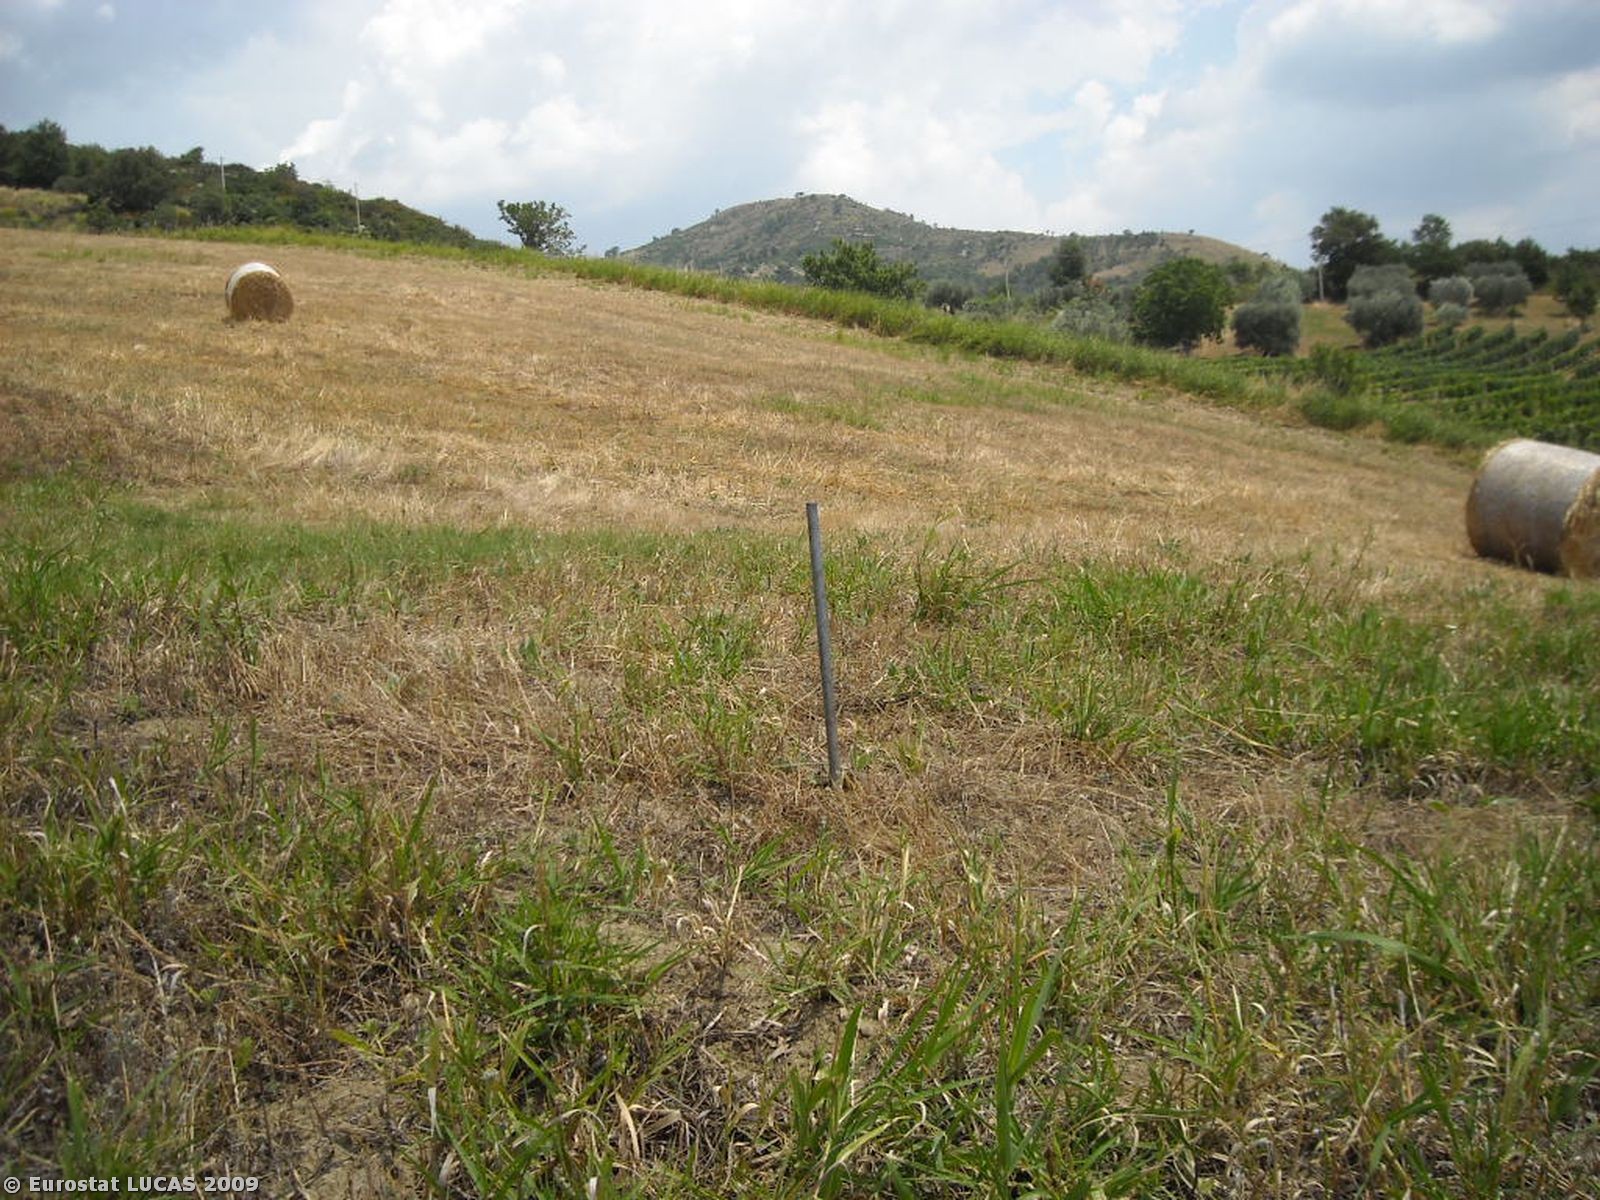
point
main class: Cropland
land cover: Mixed cereals for fodder
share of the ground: < 10 %
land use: Agriculture (excluding fallow land and kitchen gardens)
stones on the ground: < 10 %
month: July
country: IT
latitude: 40.6014
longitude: 16.1339
